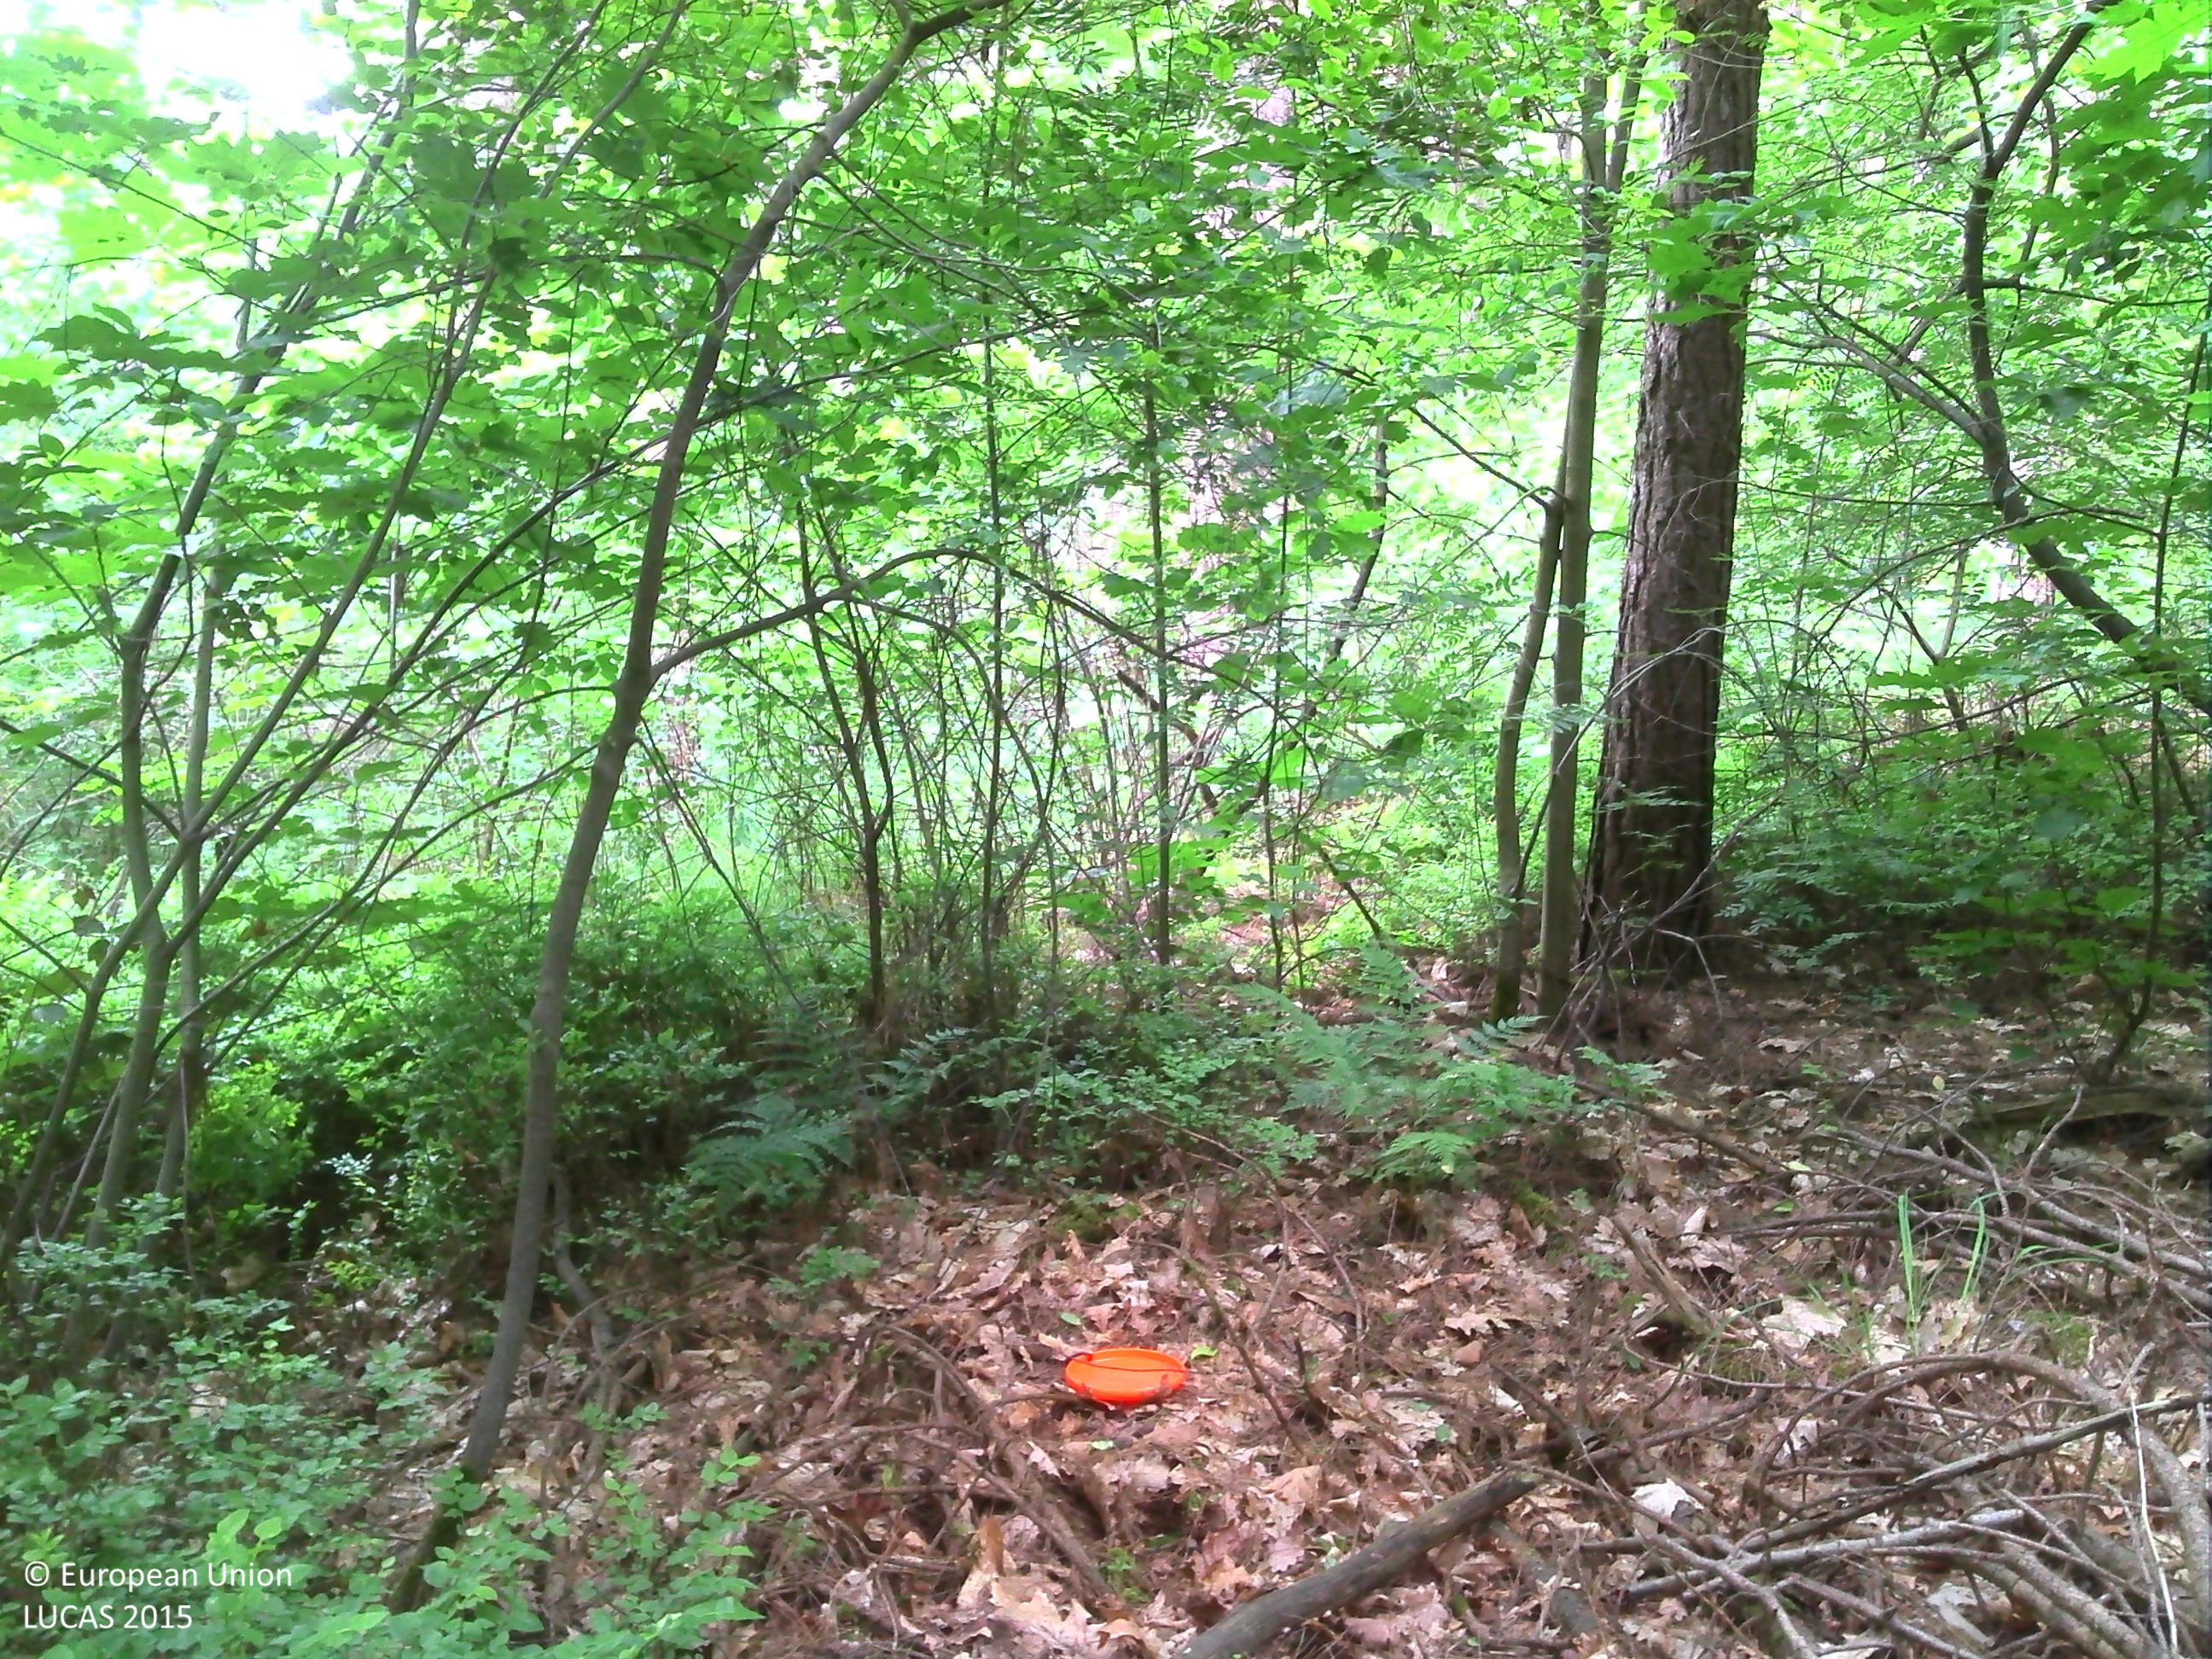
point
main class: Woodland
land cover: Pine dominated mixed woodland
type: acidophilous oak and oak-birch forest
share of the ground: > 75 %
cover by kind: broadleaved forest trees 70 %, coniferous forest trees 25 %, herbaceous plants 5 %
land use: Forestry
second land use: Sport
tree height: > 5 m
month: June
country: BE
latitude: 51.0207
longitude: 5.6789
